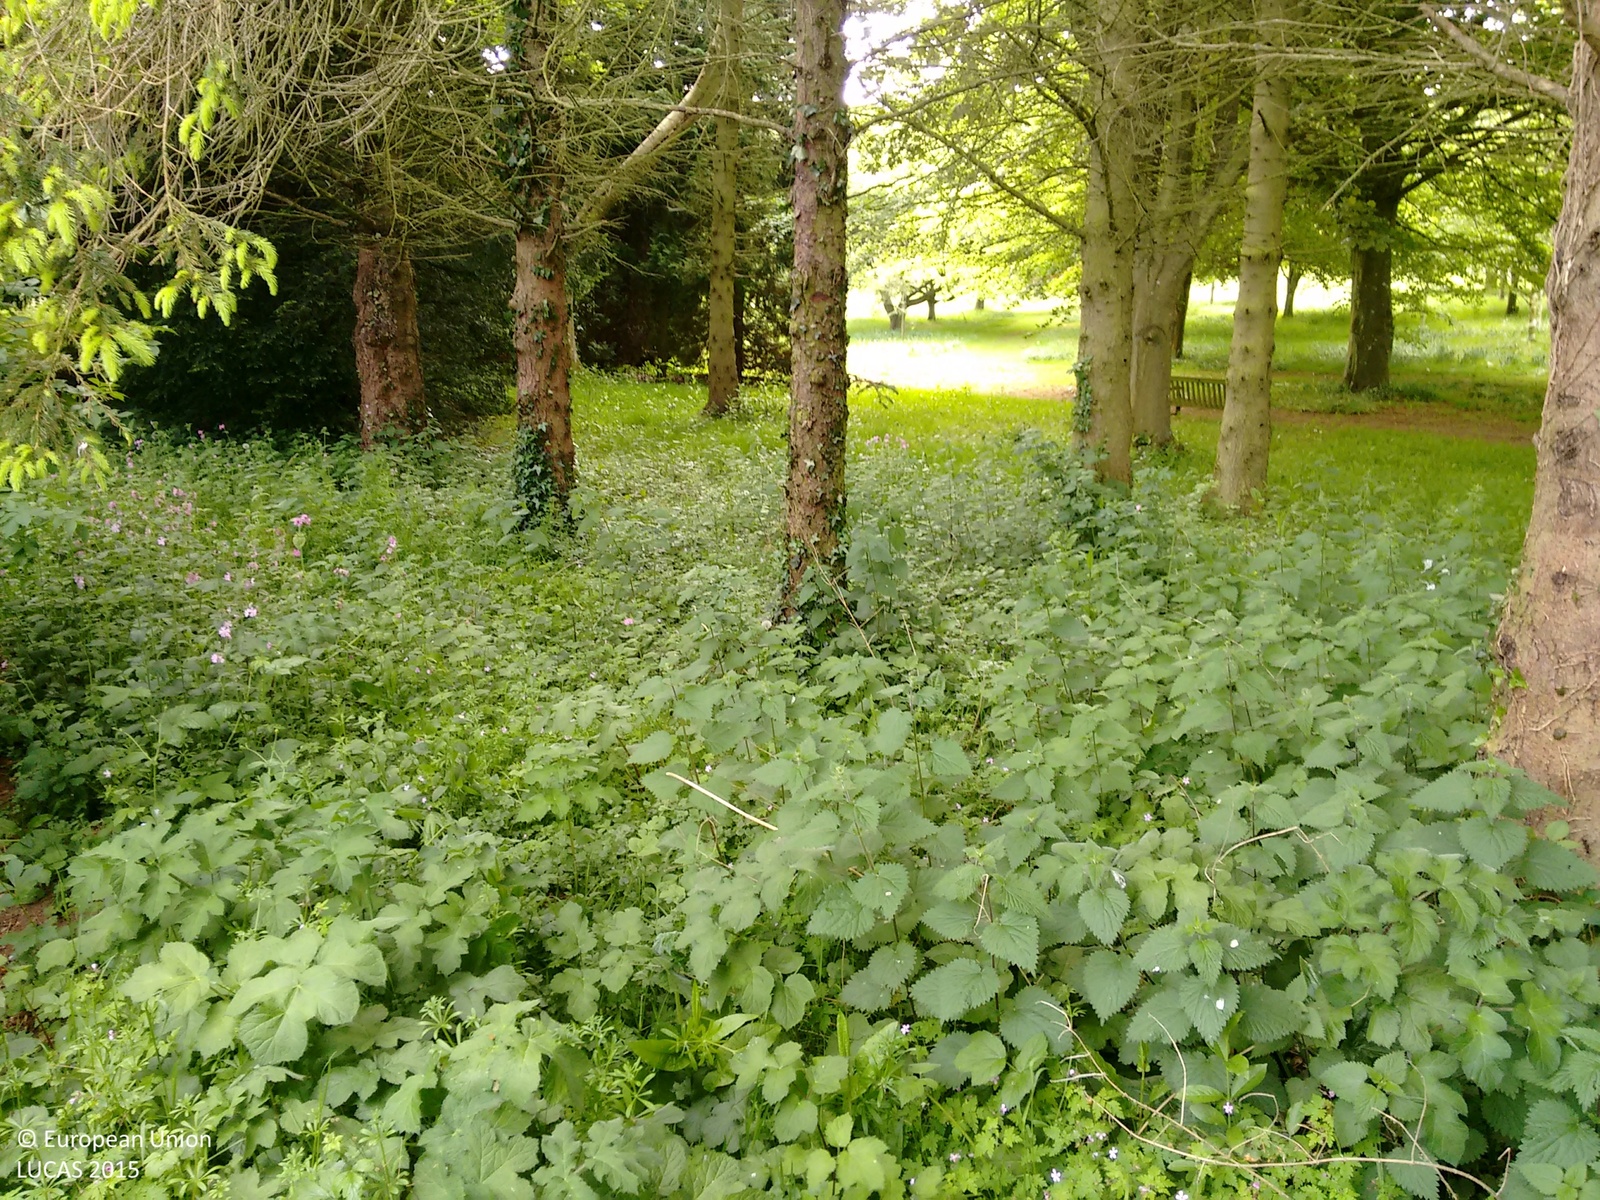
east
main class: Grassland
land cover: Spontaneously vegetated surfaces
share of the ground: > 75 %
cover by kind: herbaceous plants 95 %, shrubs 5 %
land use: Semi-natural and natural areas not in use
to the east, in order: Spontaneously vegetated surfaces; Fences; Spruce dominated mixed woodland; Tracks; Spruce dominated mixed woodland; Grassland with sparse tree/shrub cover; Tracks; Grassland with sparse tree/shrub cover; Artificial constructions in urban areas; Broadleaved woodland; Tracks; Broadleaved woodland; Fences; Broadleaved woodland; Paved roads, cycling and walking lanes
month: May
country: GB
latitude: 51.1983
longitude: 1.1768
